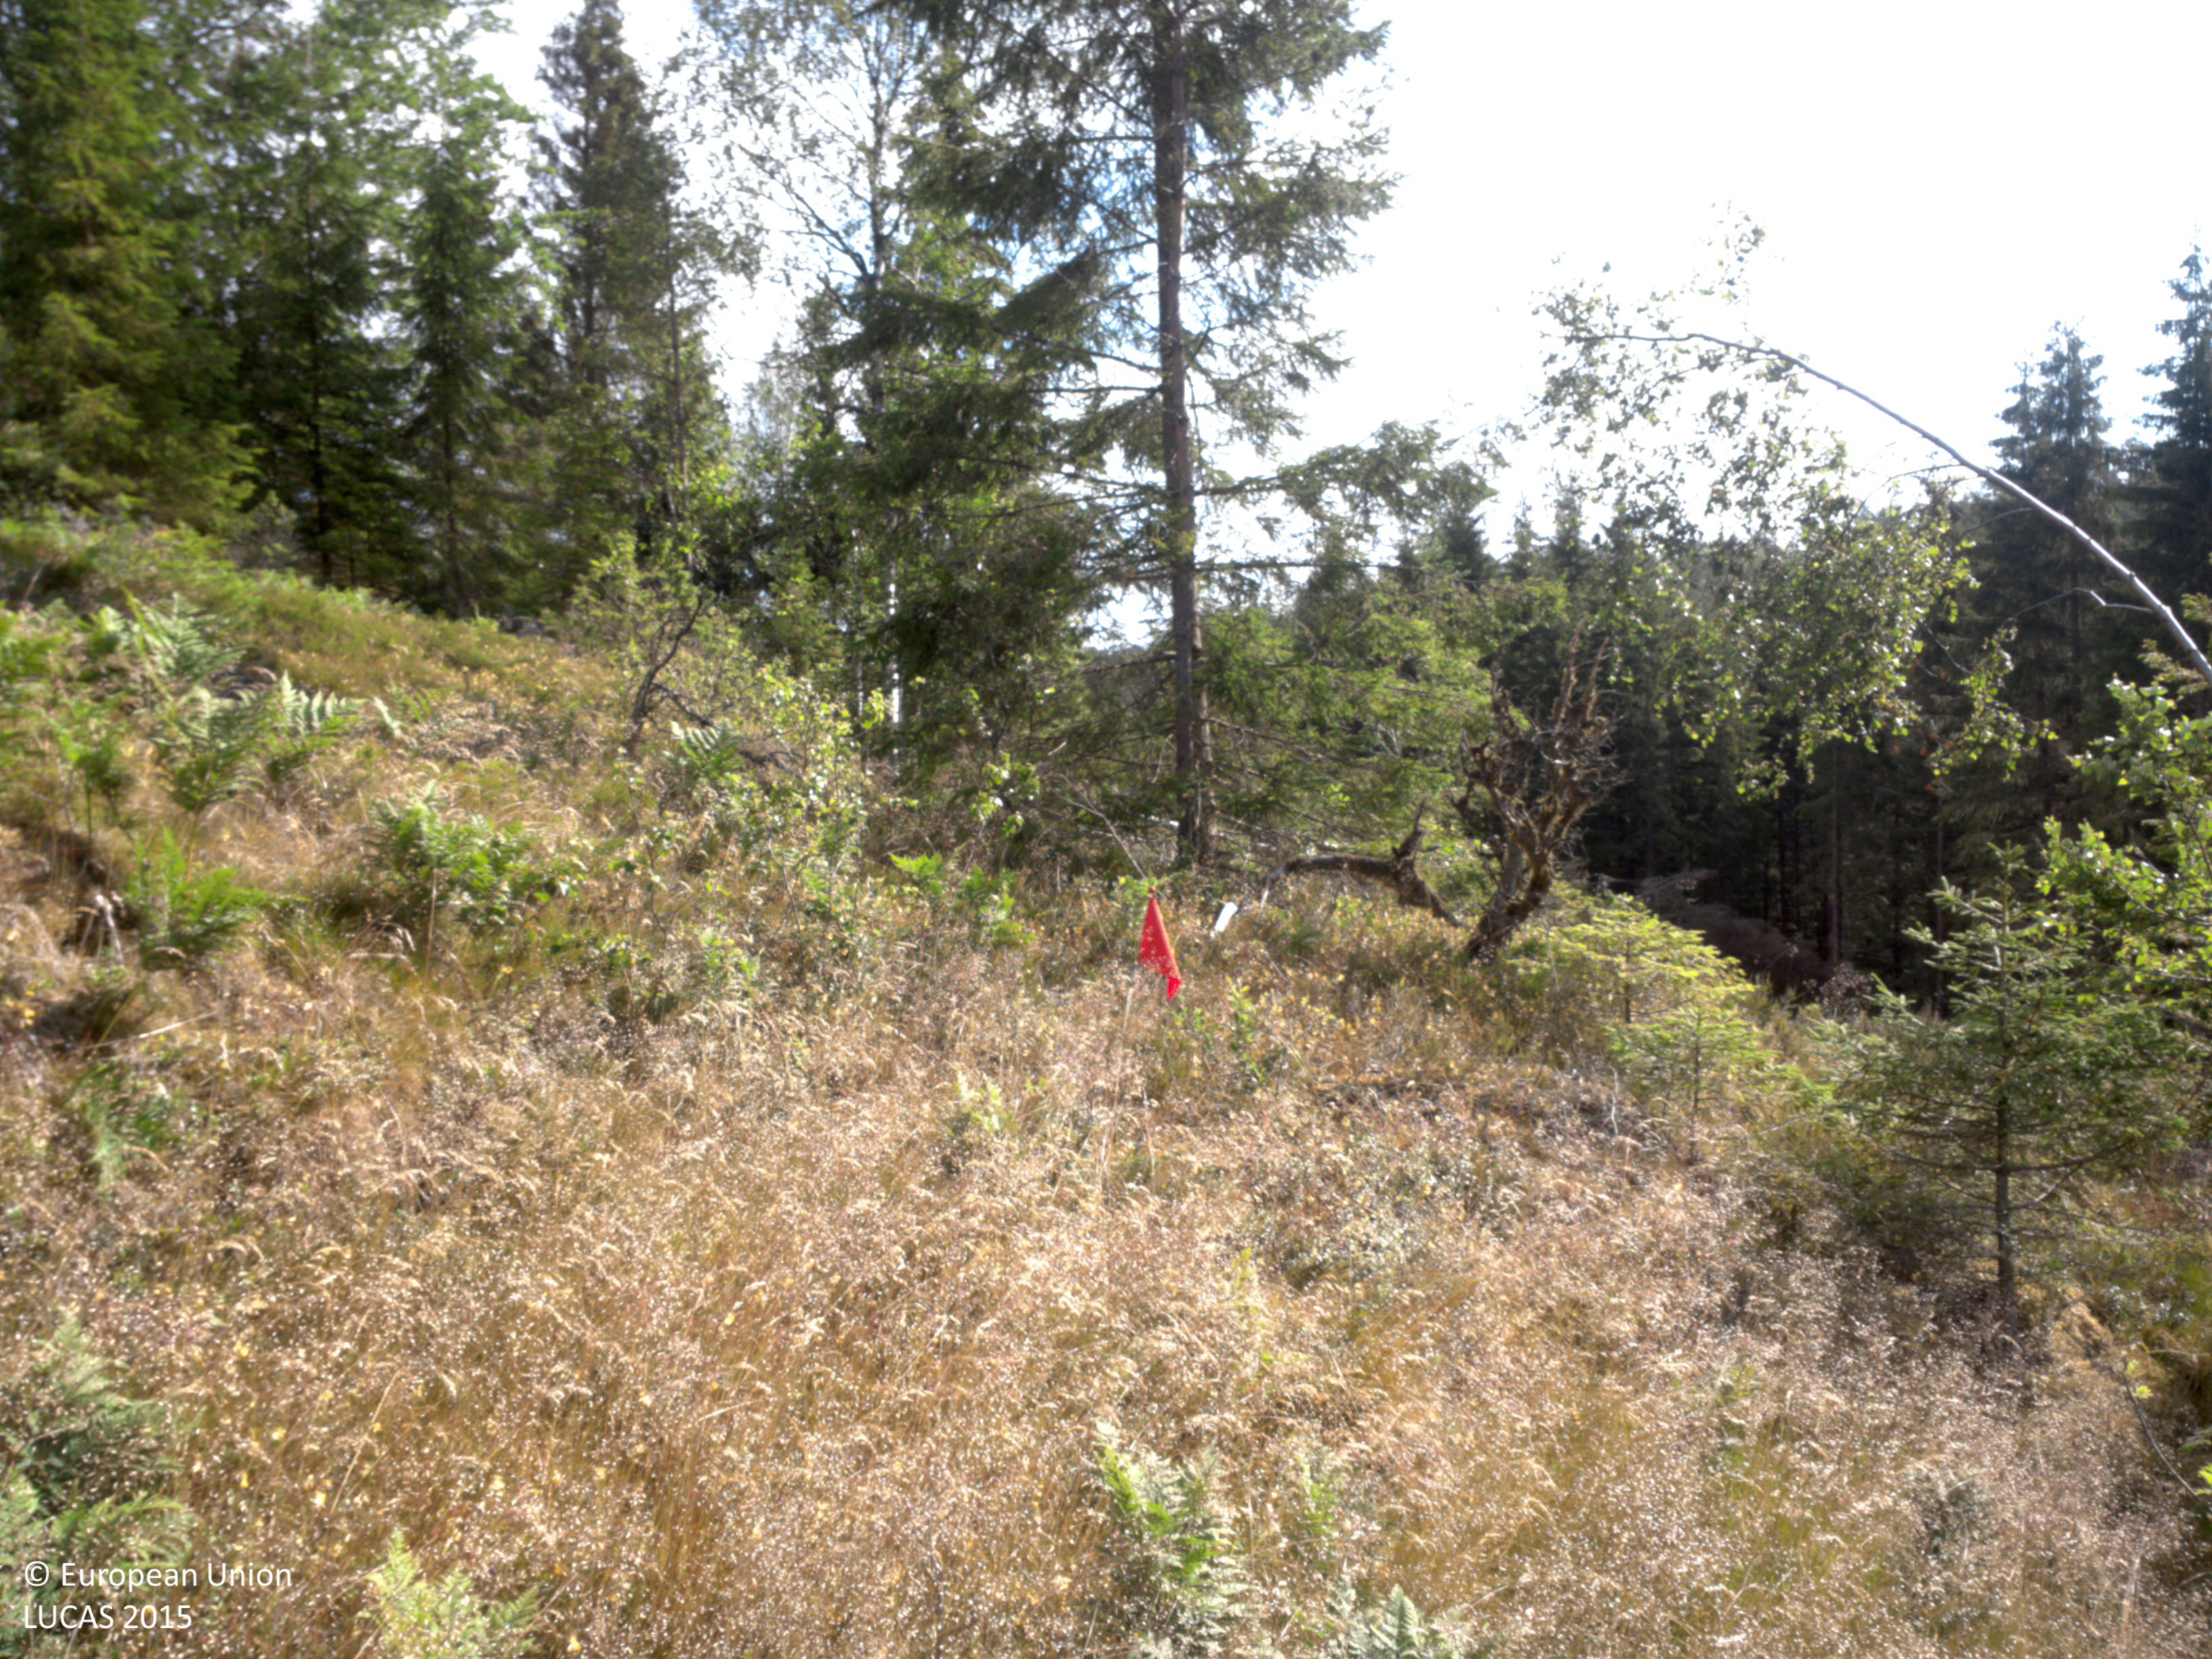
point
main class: Shrubland
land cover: Shrubland with sparse tree cover
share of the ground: 25 - 50 %
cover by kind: herbaceous plants 60 %, shrubs 30 %, broadleaved forest trees 5 %, lichens and mosses 5 %
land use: Forestry
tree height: > 5 m
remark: Clear cut
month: July
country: SE
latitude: 58.8010
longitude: 11.8132
